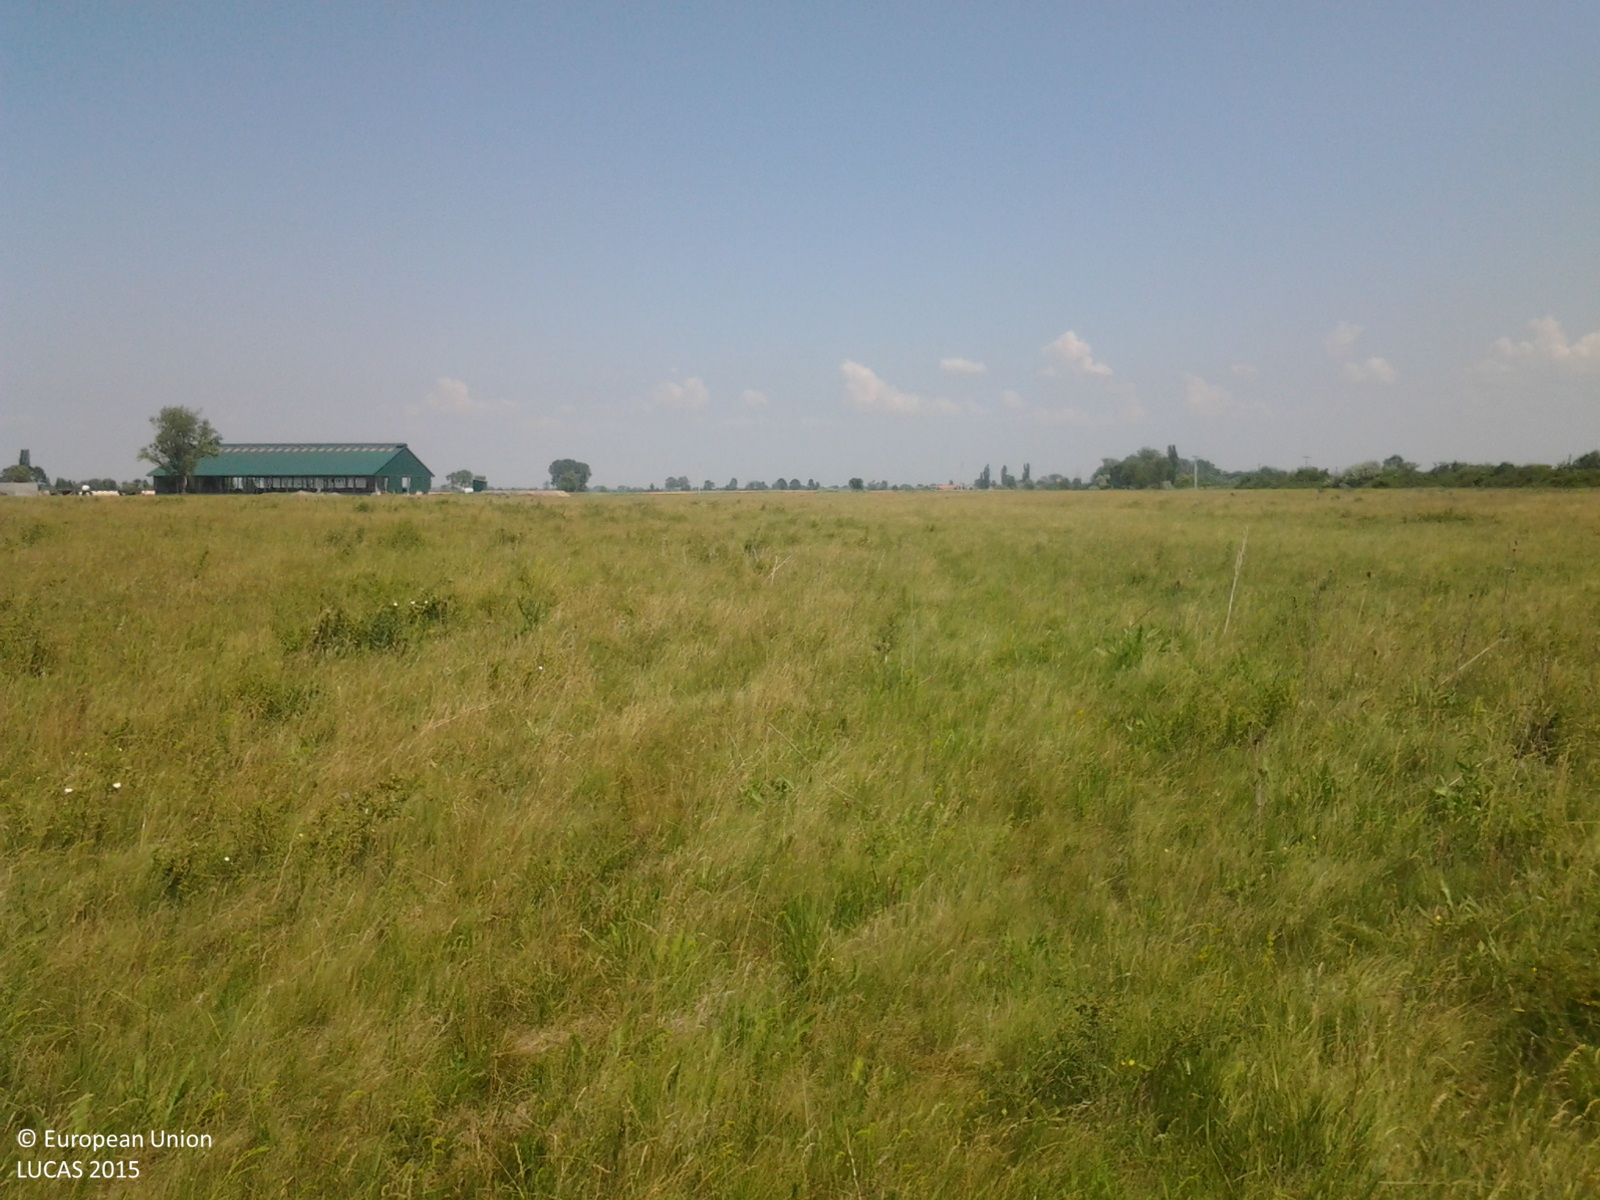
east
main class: Grassland
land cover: Grassland without tree/shrub cover
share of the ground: > 75 %
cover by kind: herbaceous plants 100 %
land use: Agriculture (excluding fallow land and kitchen gardens)
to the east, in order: Grassland without tree/shrub cover
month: June
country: HU
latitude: 46.5243
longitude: 19.1006
